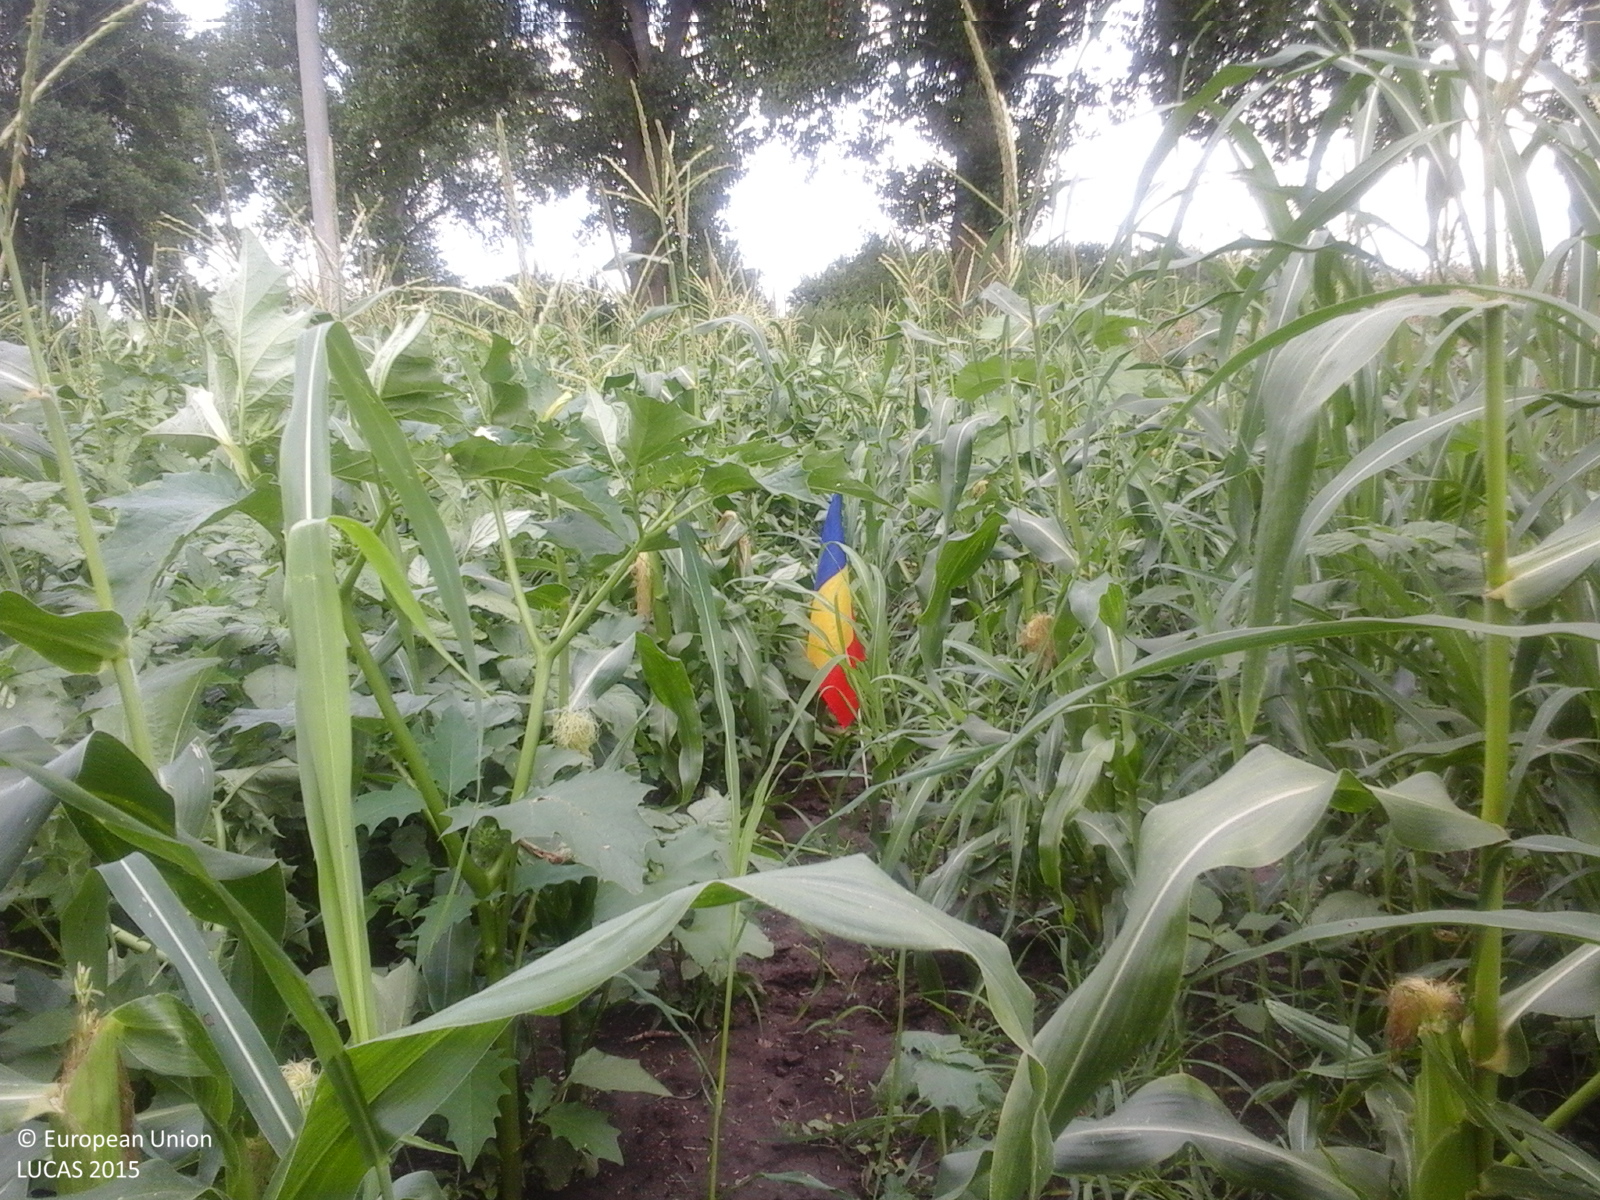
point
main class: Cropland
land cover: Maize
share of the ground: 50 - 75 %
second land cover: Other fresh vegetables
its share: 25 - 50 %
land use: Agriculture (excluding fallow land and kitchen gardens)
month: July
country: RO
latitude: 43.7345
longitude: 25.6948
